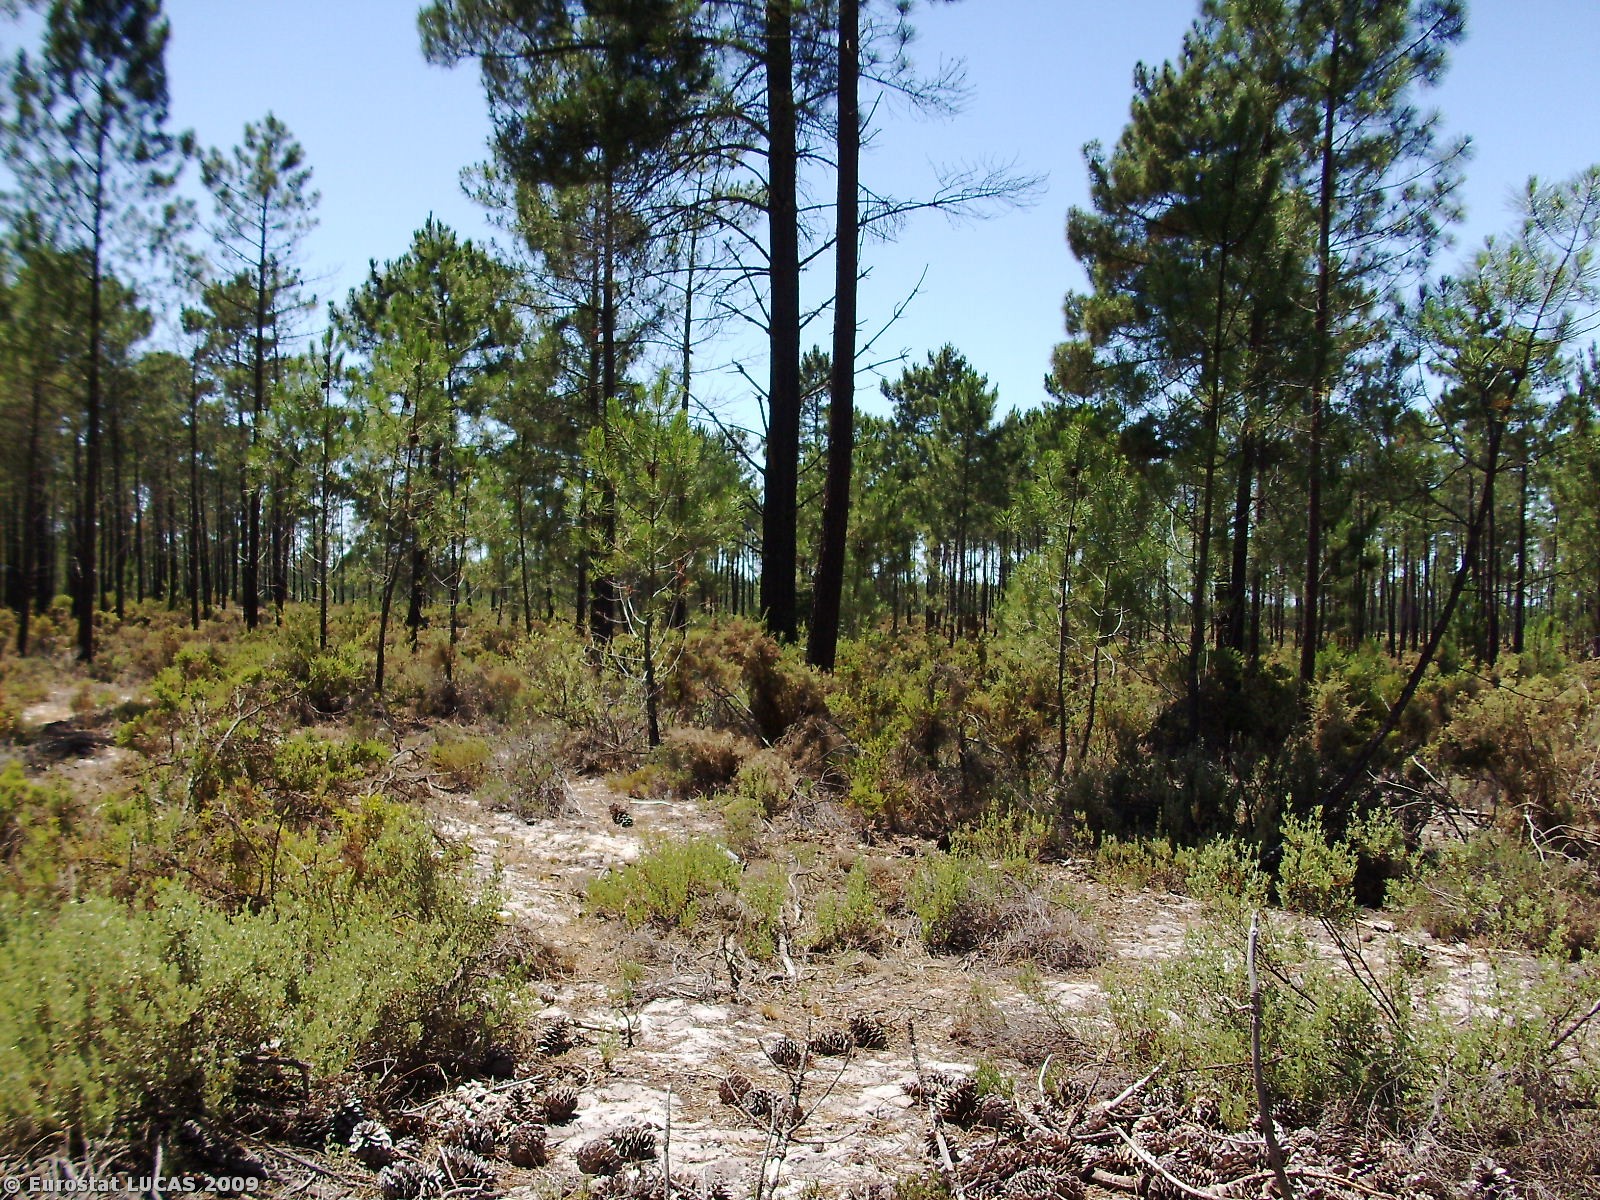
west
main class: Woodland
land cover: Coniferous woodland
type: coniferous forest of the mediterranean region
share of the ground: 50 - 75 %
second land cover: Shrubland with sparse tree cover
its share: 25 - 50 %
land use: Forestry
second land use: Agriculture (excluding fallow land and kitchen gardens)
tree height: > 5 m
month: June
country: PT
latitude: 38.2757
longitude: -8.6507
